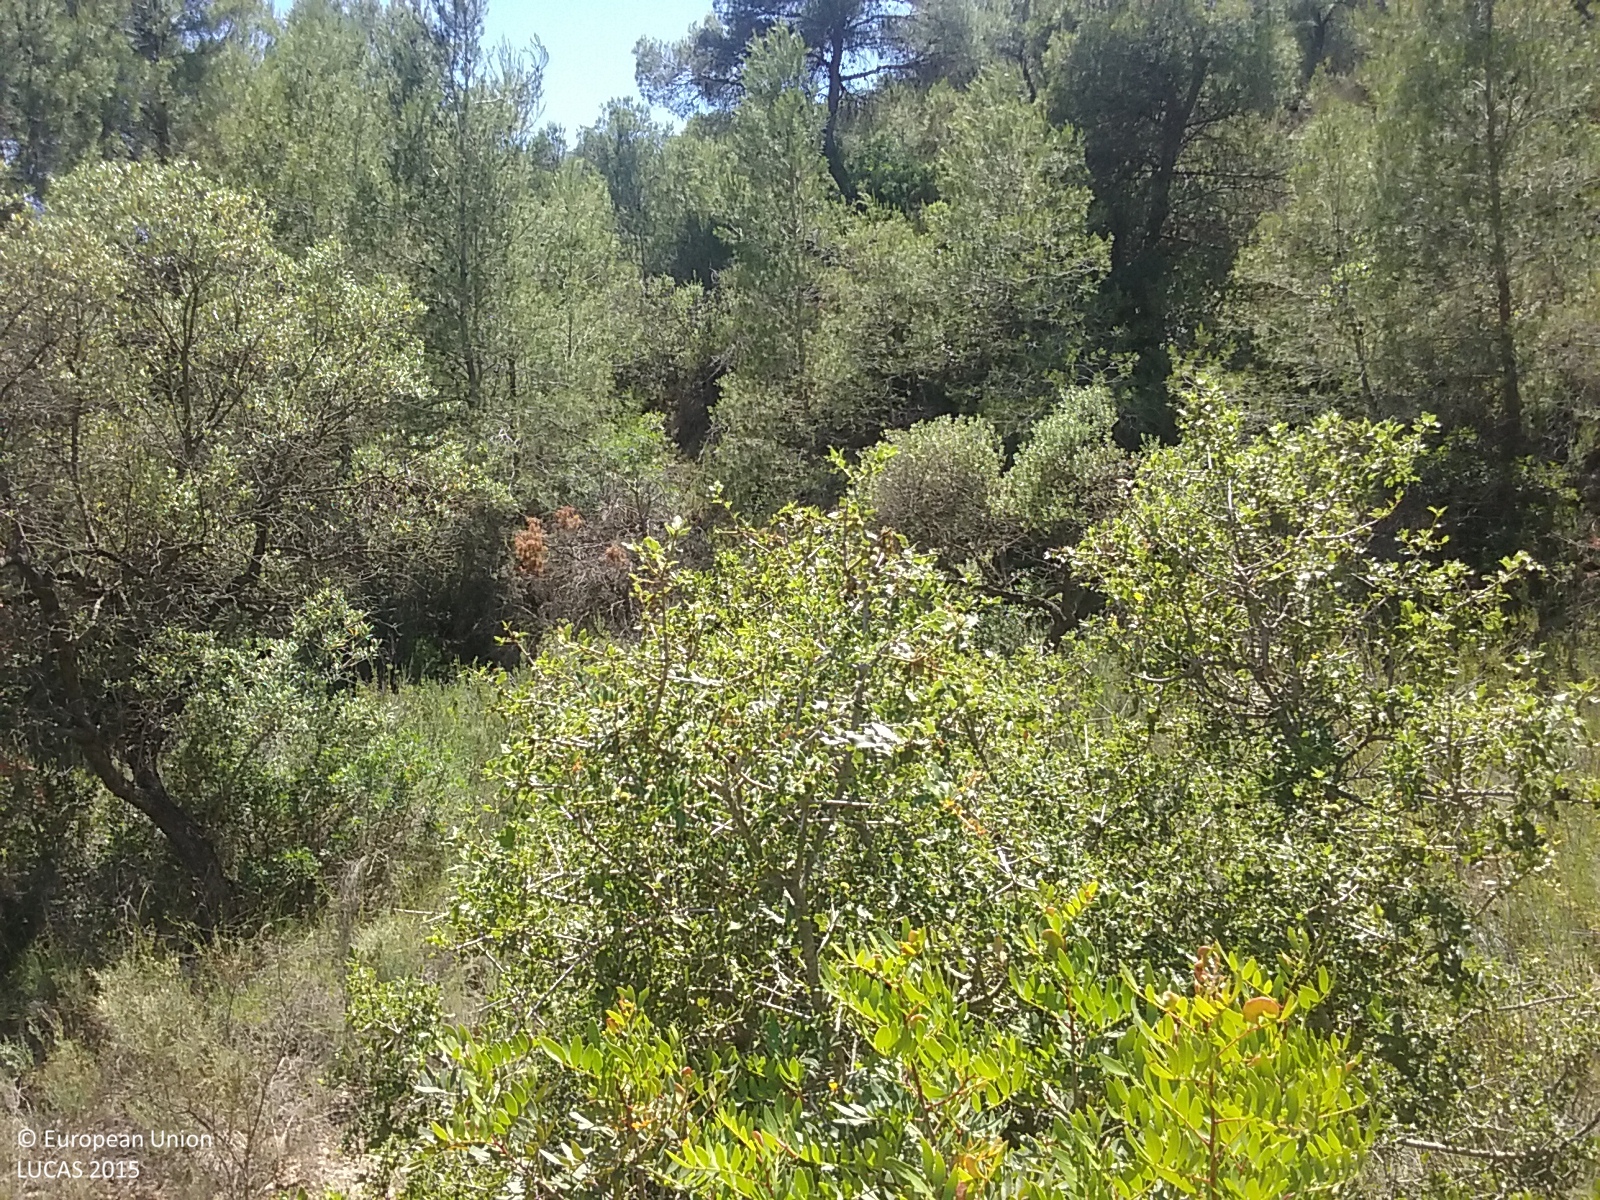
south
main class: Woodland
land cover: Pine dominated coniferous woodland
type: coniferous forest of the mediterranean region
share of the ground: 10 - 25 %
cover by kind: shrubs 75 %, coniferous forest trees 25 %
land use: Semi-natural and natural areas not in use
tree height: > 5 m
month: June
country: ES
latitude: 41.3128
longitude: 0.4691
